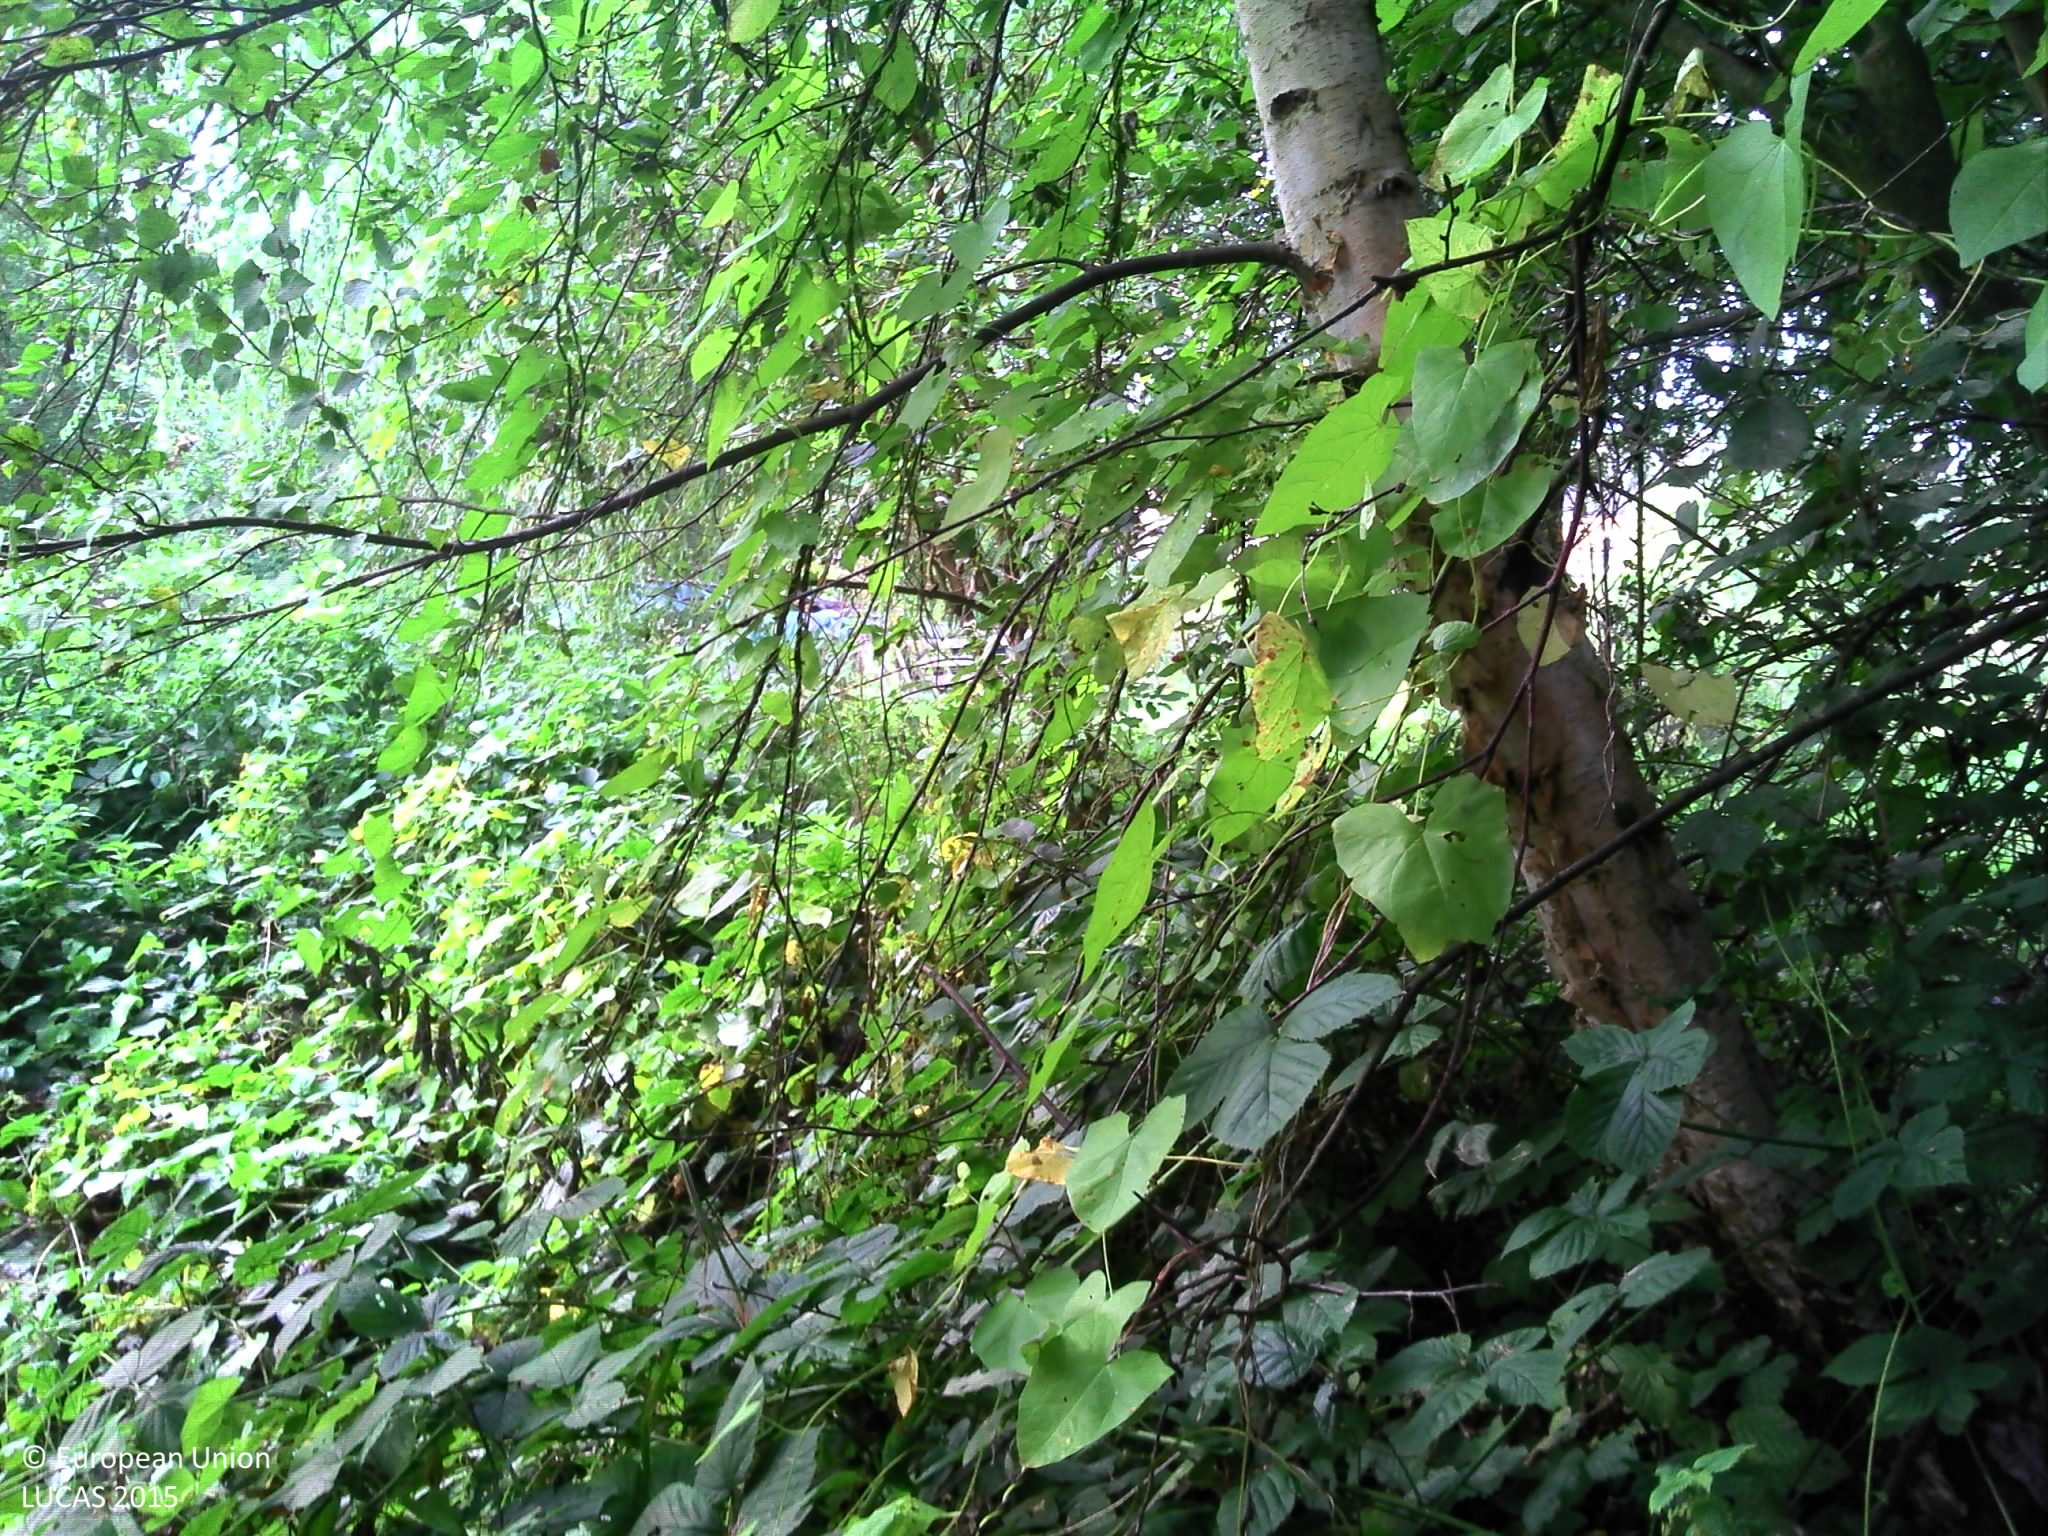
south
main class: Woodland
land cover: Broadleaved woodland
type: floodplain forest
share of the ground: > 75 %
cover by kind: broadleaved forest trees 70 %, herbaceous plants 20 %, shrubs 10 %
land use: Forestry
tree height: > 5 m
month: September
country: BE
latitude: 51.0720
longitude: 4.3579
